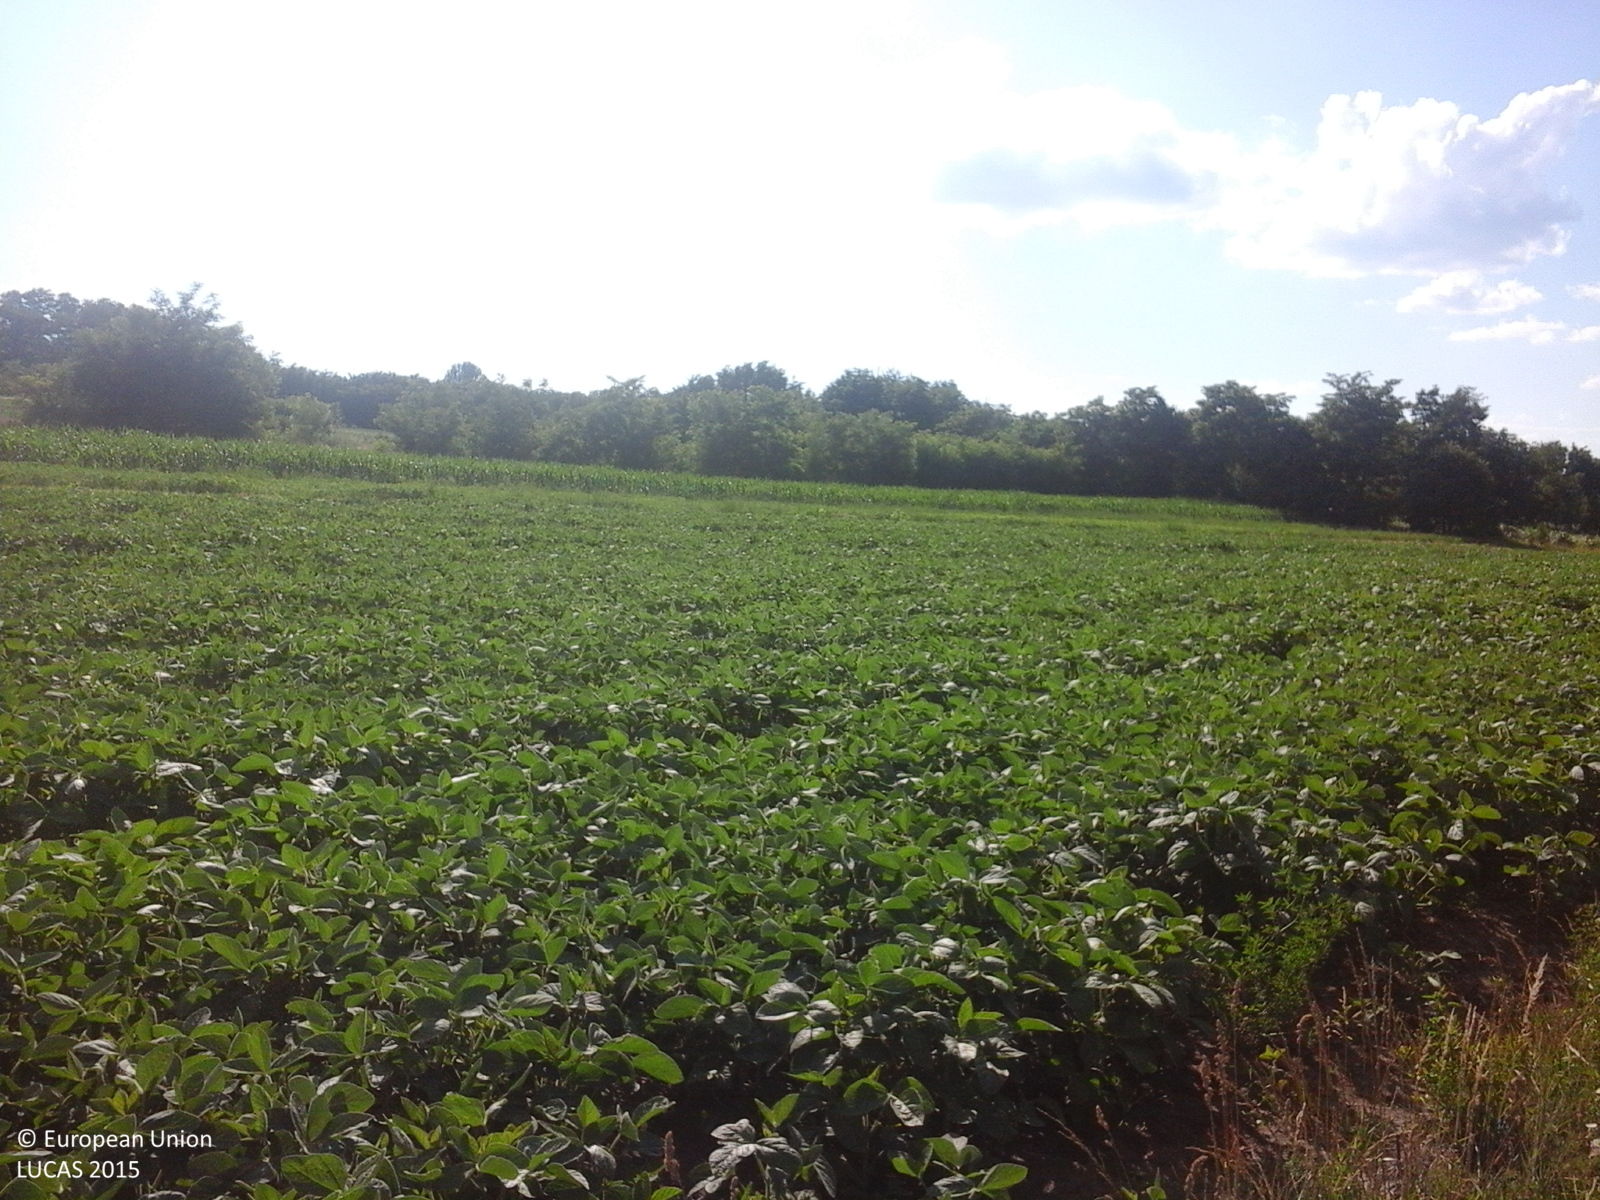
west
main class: Grassland
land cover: Grassland without tree/shrub cover
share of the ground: > 75 %
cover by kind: herbaceous plants 100 %
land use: Agriculture (excluding fallow land and kitchen gardens)
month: June
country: RO
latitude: 48.2418
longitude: 26.7021
